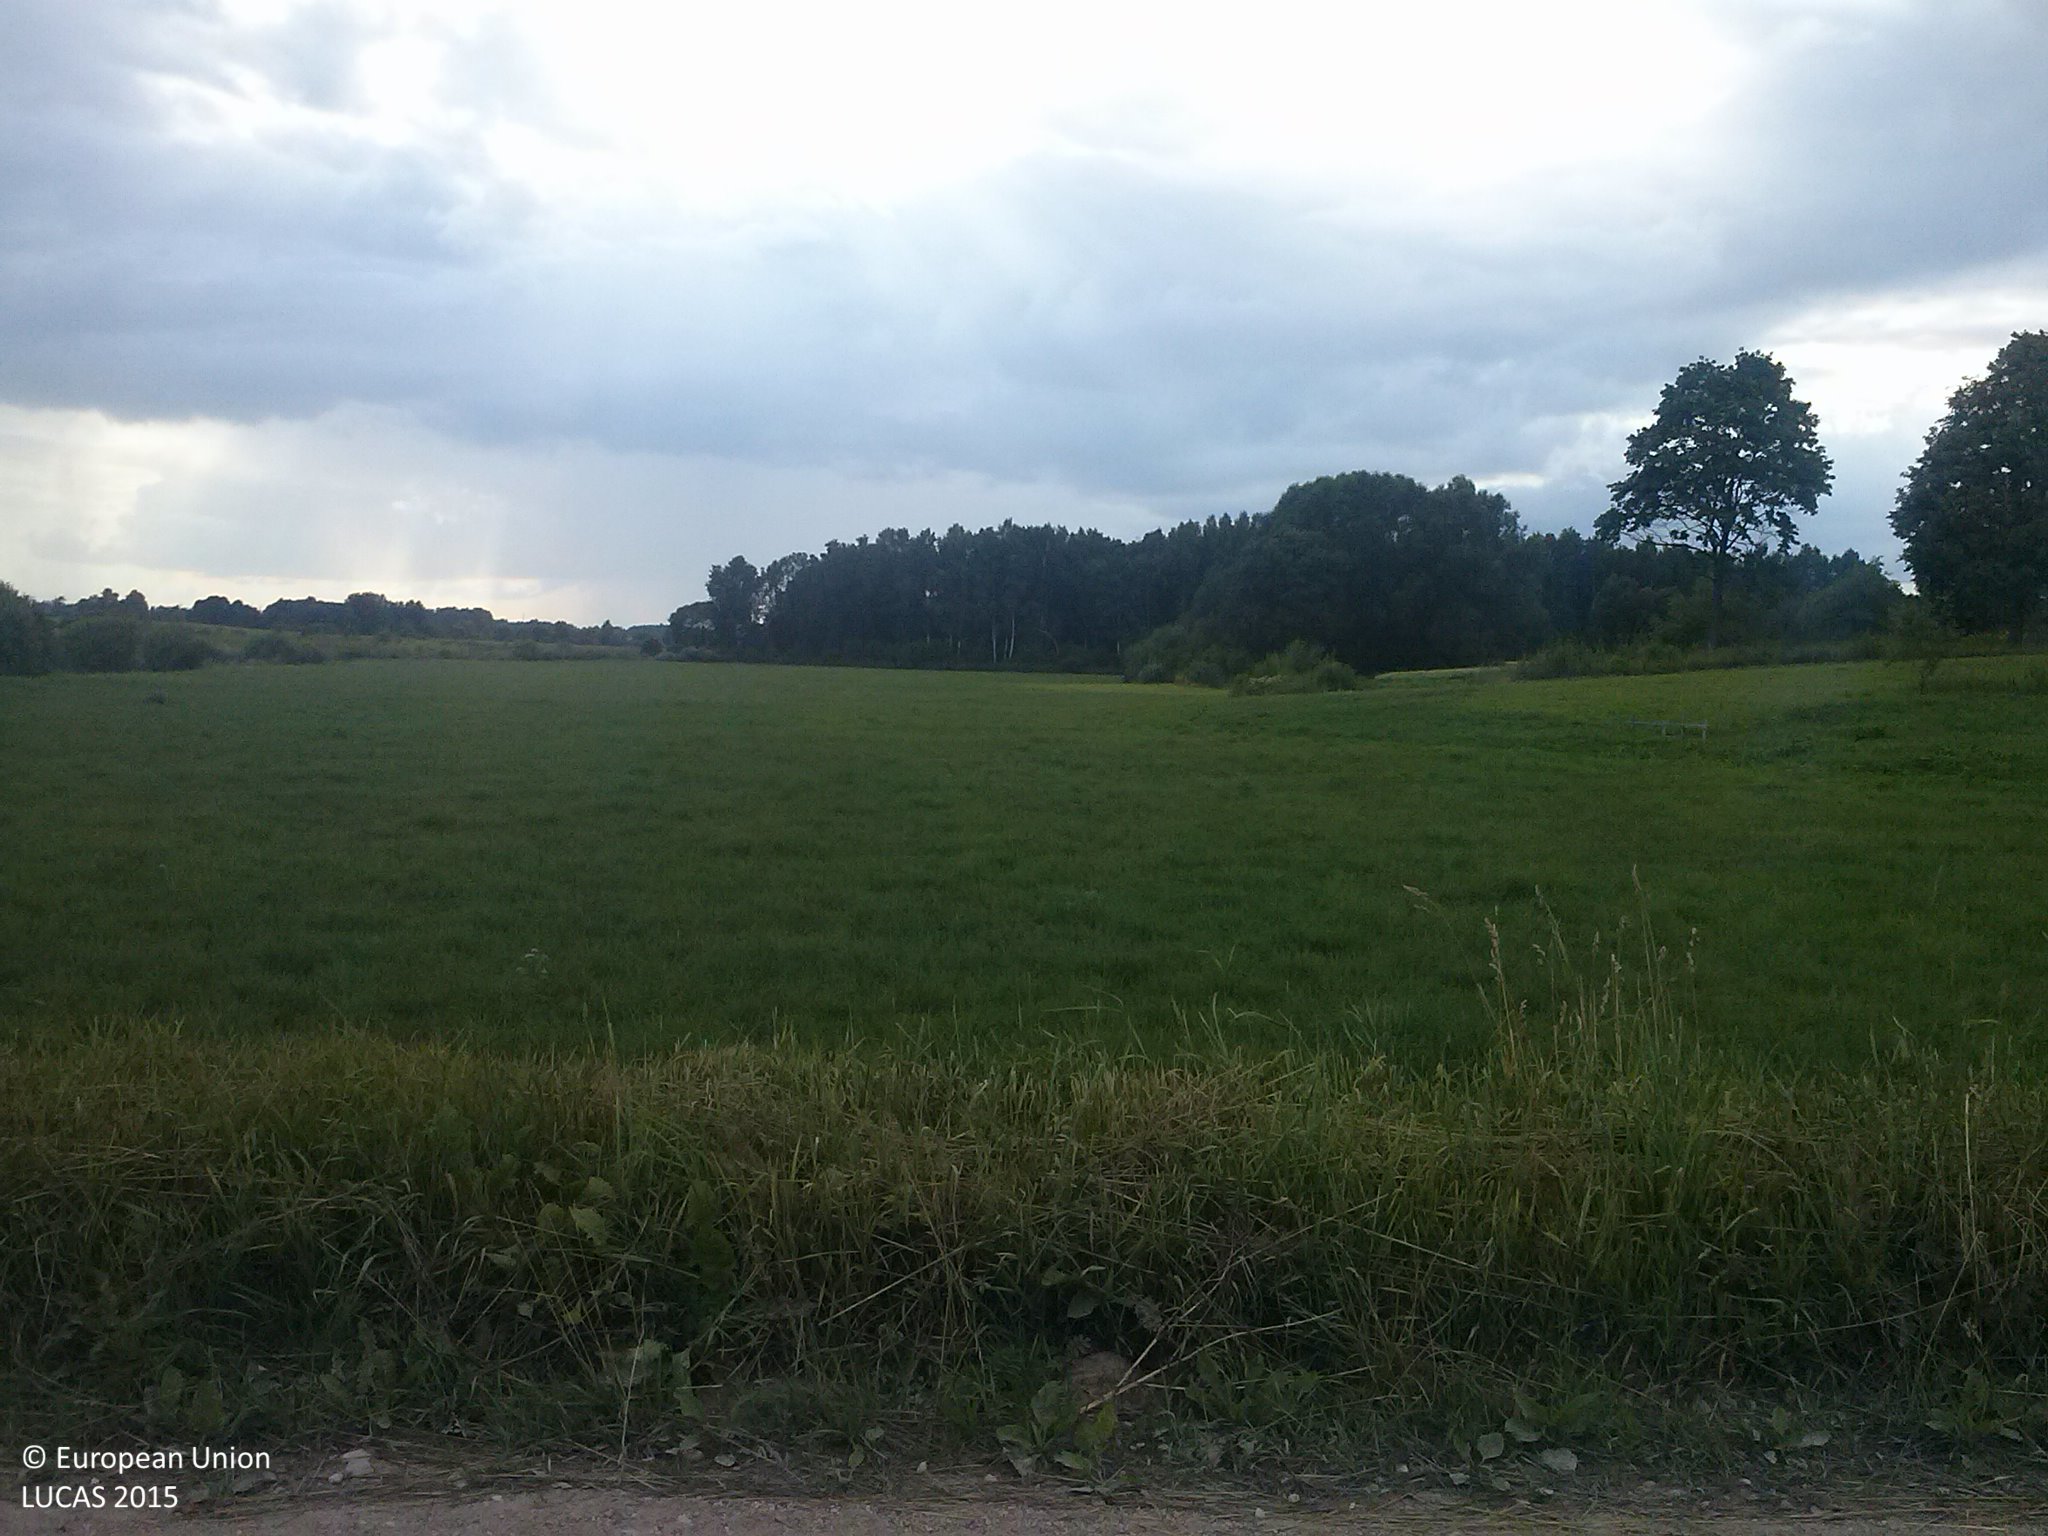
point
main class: Grassland
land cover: Grassland without tree/shrub cover
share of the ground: > 75 %
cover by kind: herbaceous plants 100 %
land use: Agriculture (excluding fallow land and kitchen gardens)
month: July
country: LV
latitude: 56.7176
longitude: 27.4130
